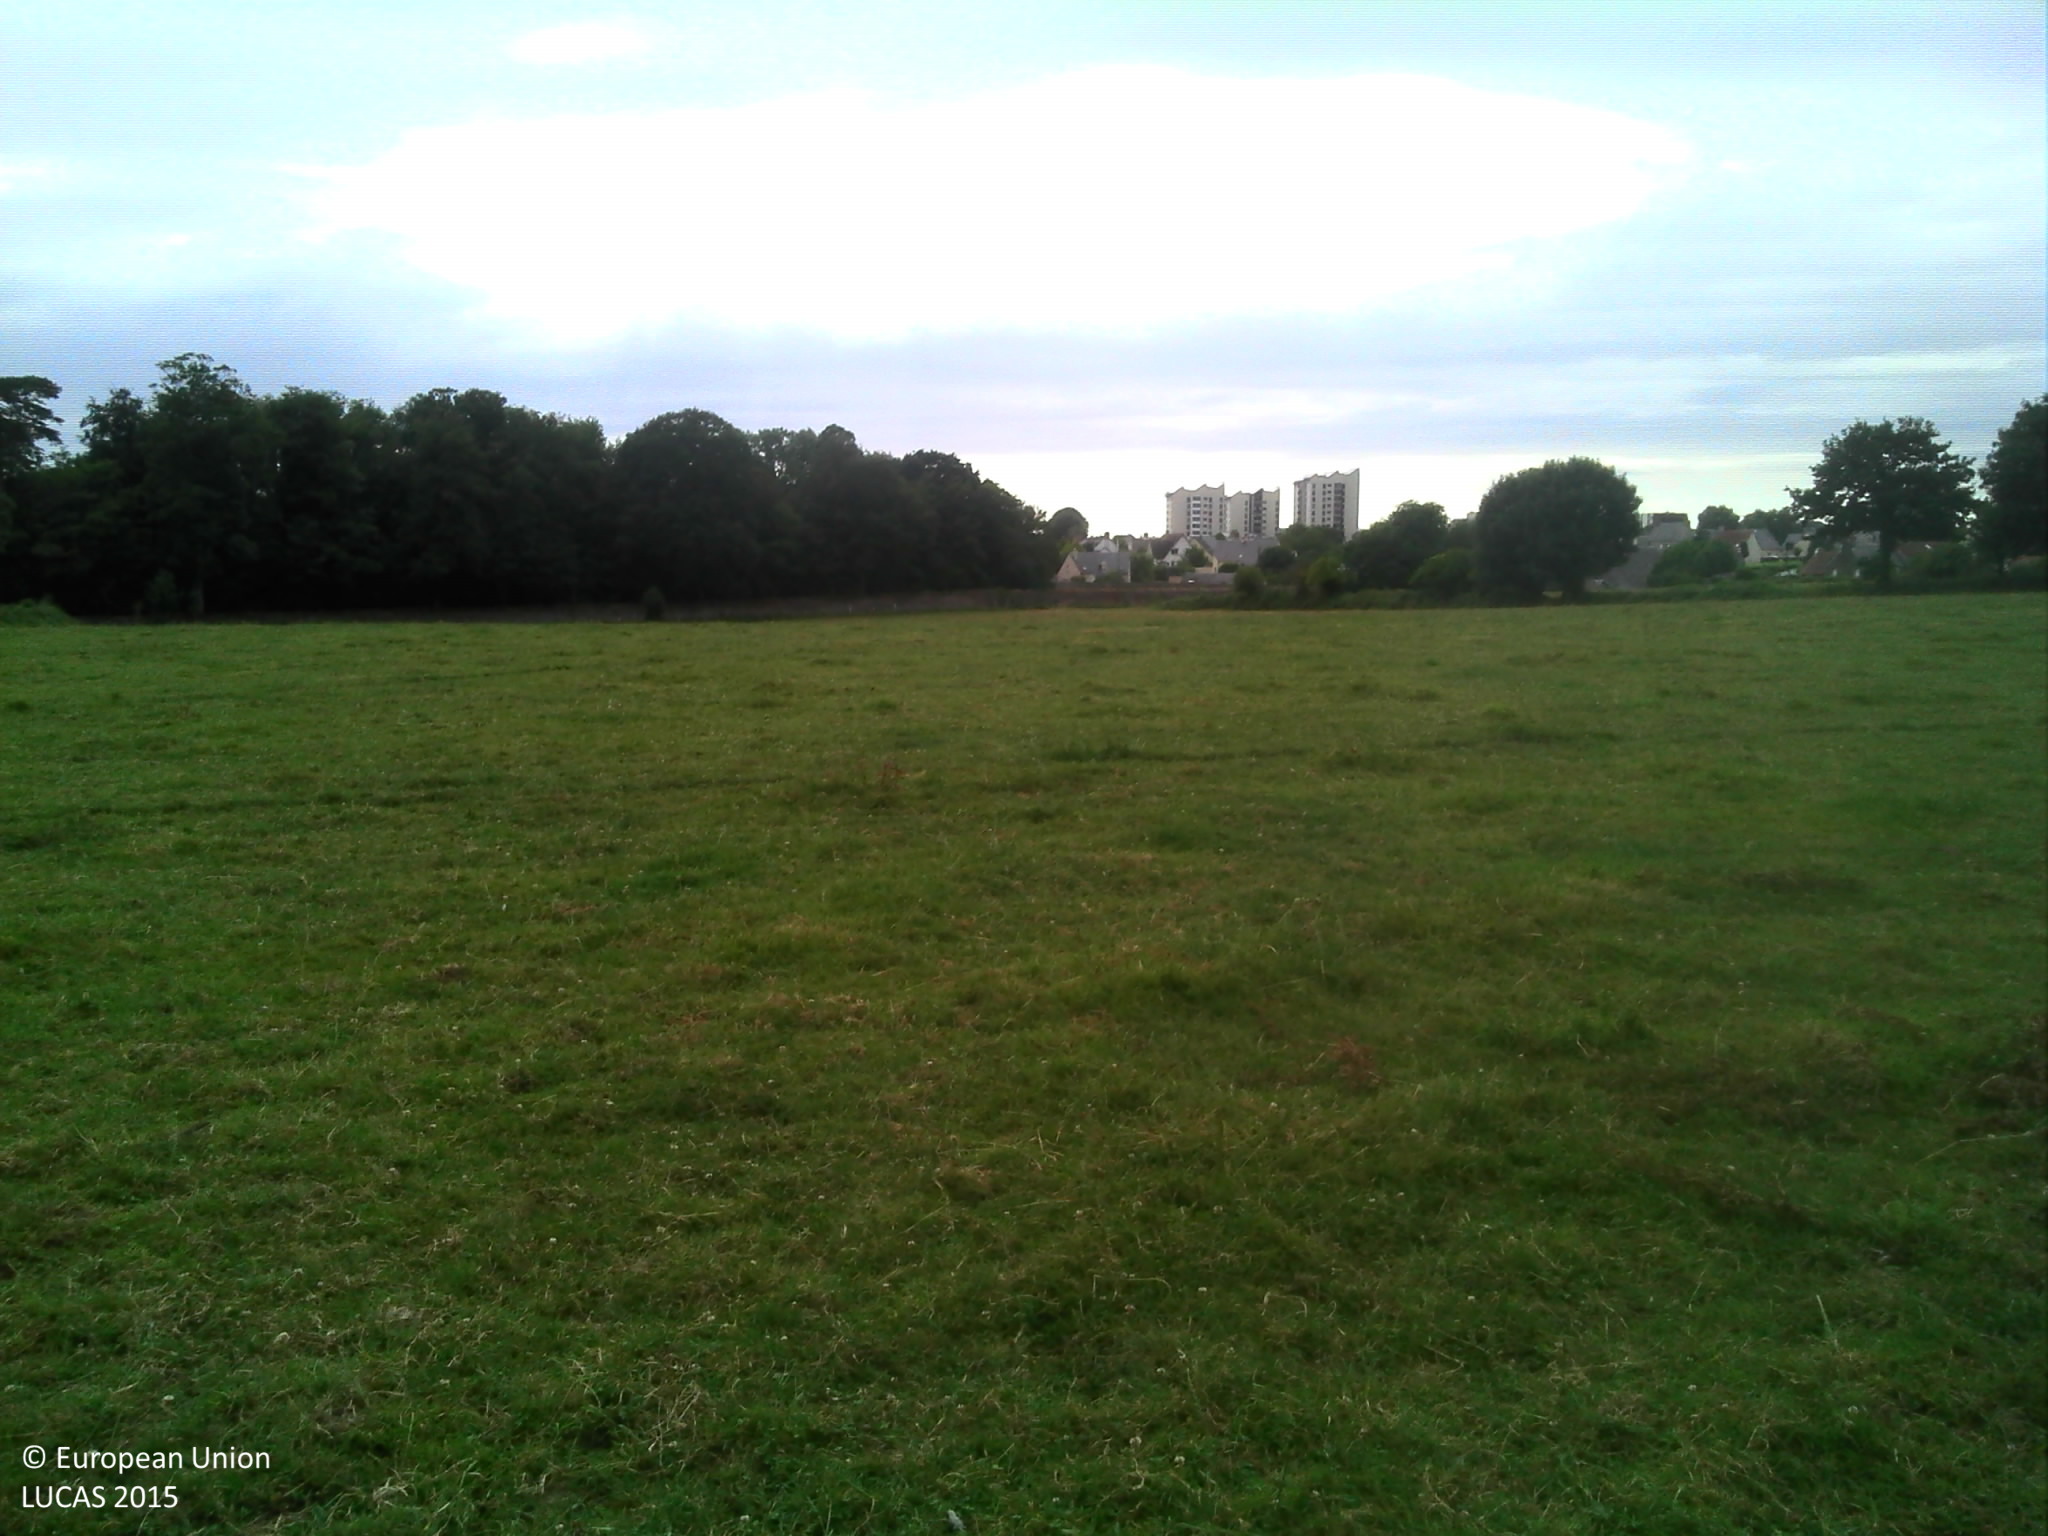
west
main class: Grassland
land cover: Grassland without tree/shrub cover
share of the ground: > 75 %
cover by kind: herbaceous plants 100 %
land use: Agriculture (excluding fallow land and kitchen gardens)
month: July
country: FR
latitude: 48.8308
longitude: -1.5600
